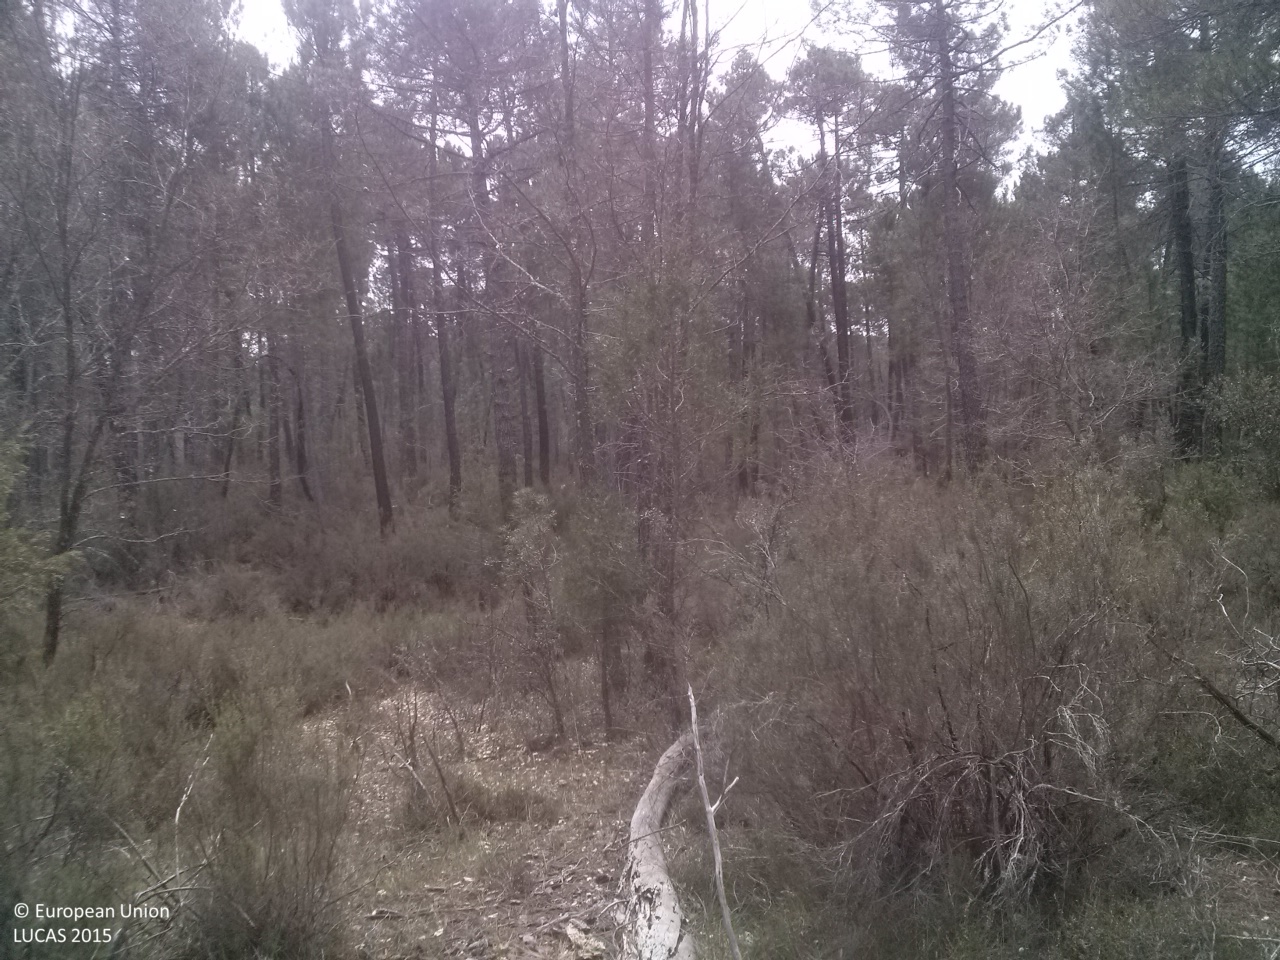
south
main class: Woodland
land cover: Pine dominated mixed woodland
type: coniferous forest of the mediterranean region
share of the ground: 50 - 75 %
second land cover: Shrubland without tree cover
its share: 10 - 25 %
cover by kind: coniferous forest trees 55 %, broadleaved forest trees 20 %, shrubs 15 %, herbaceous plants 10 %
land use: Forestry
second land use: Agriculture (excluding fallow land and kitchen gardens)
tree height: > 5 m
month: April
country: ES
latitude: 40.0354
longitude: -1.8849
